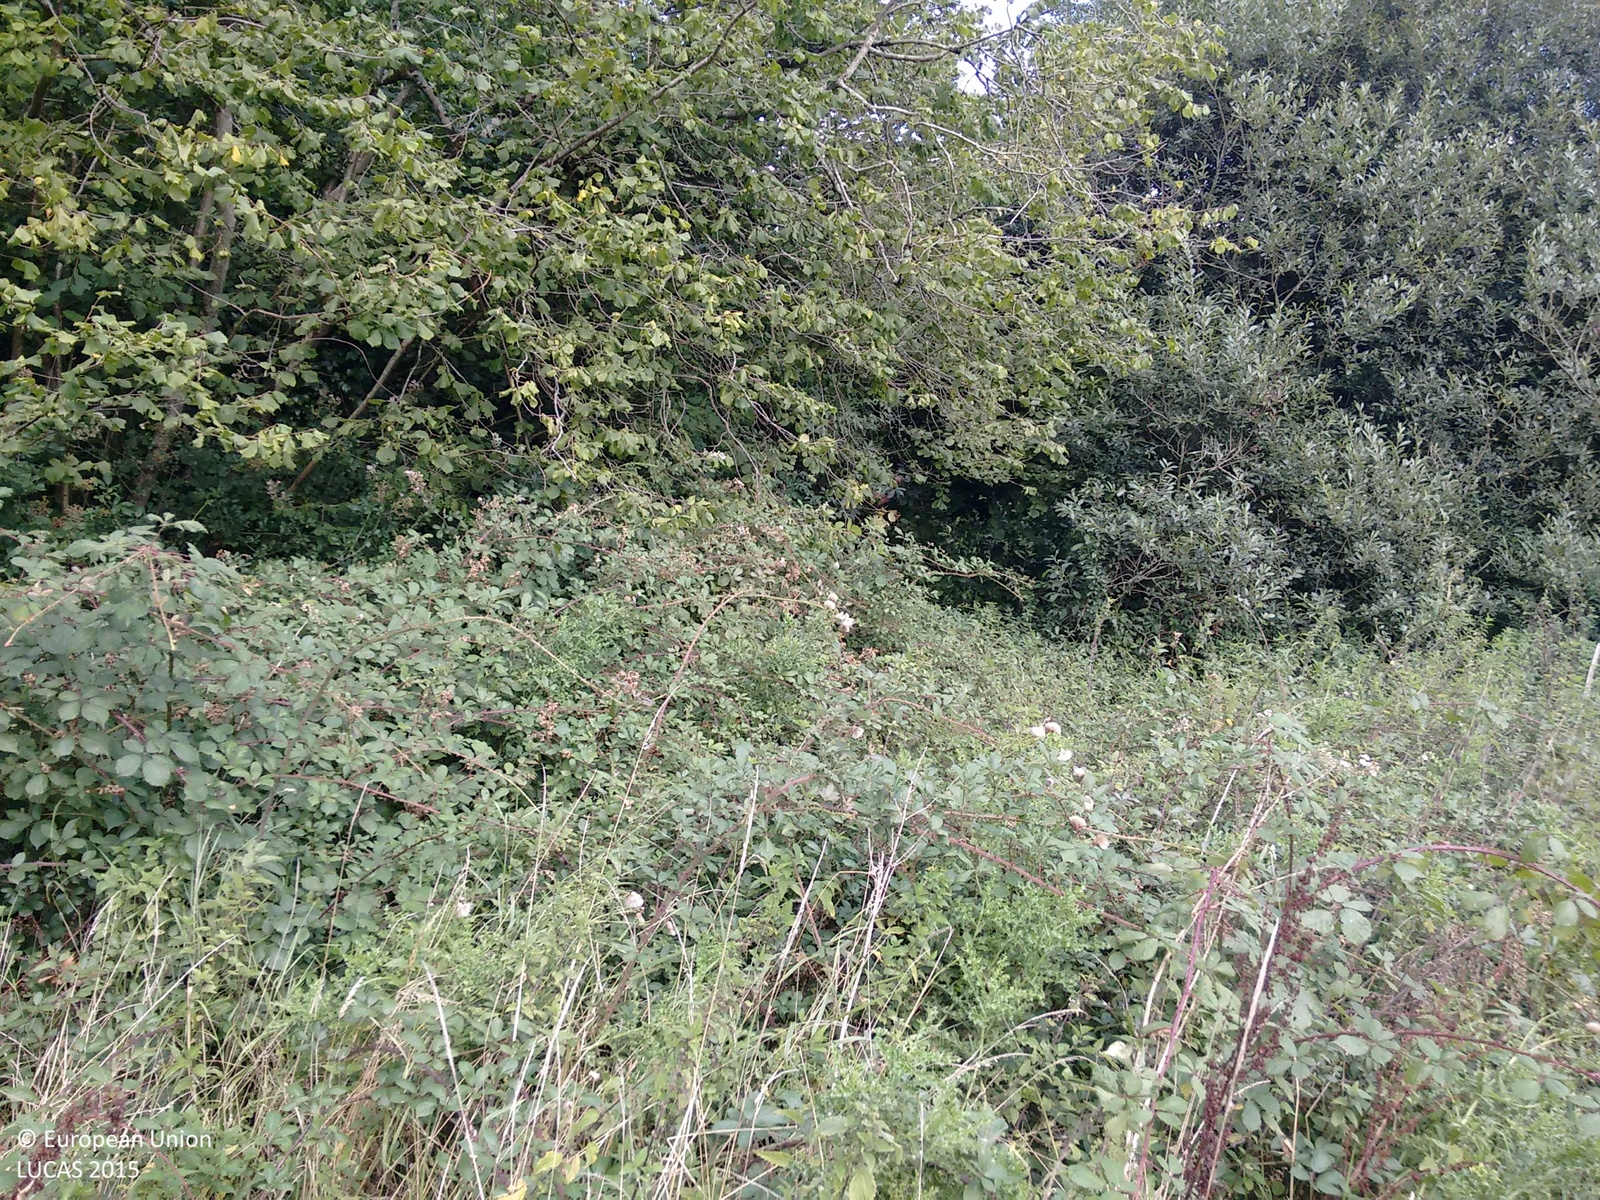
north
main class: Woodland
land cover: Broadleaved woodland
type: hemiboreal forest and nemoral coniferous forest and mixed broadleaved-coniferous forest
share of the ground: > 75 %
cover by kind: broadleaved forest trees 95 %, shrubs 5 %
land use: Semi-natural and natural areas not in use
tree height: > 5 m
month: September
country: GB
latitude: 51.0179
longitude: -4.2551
